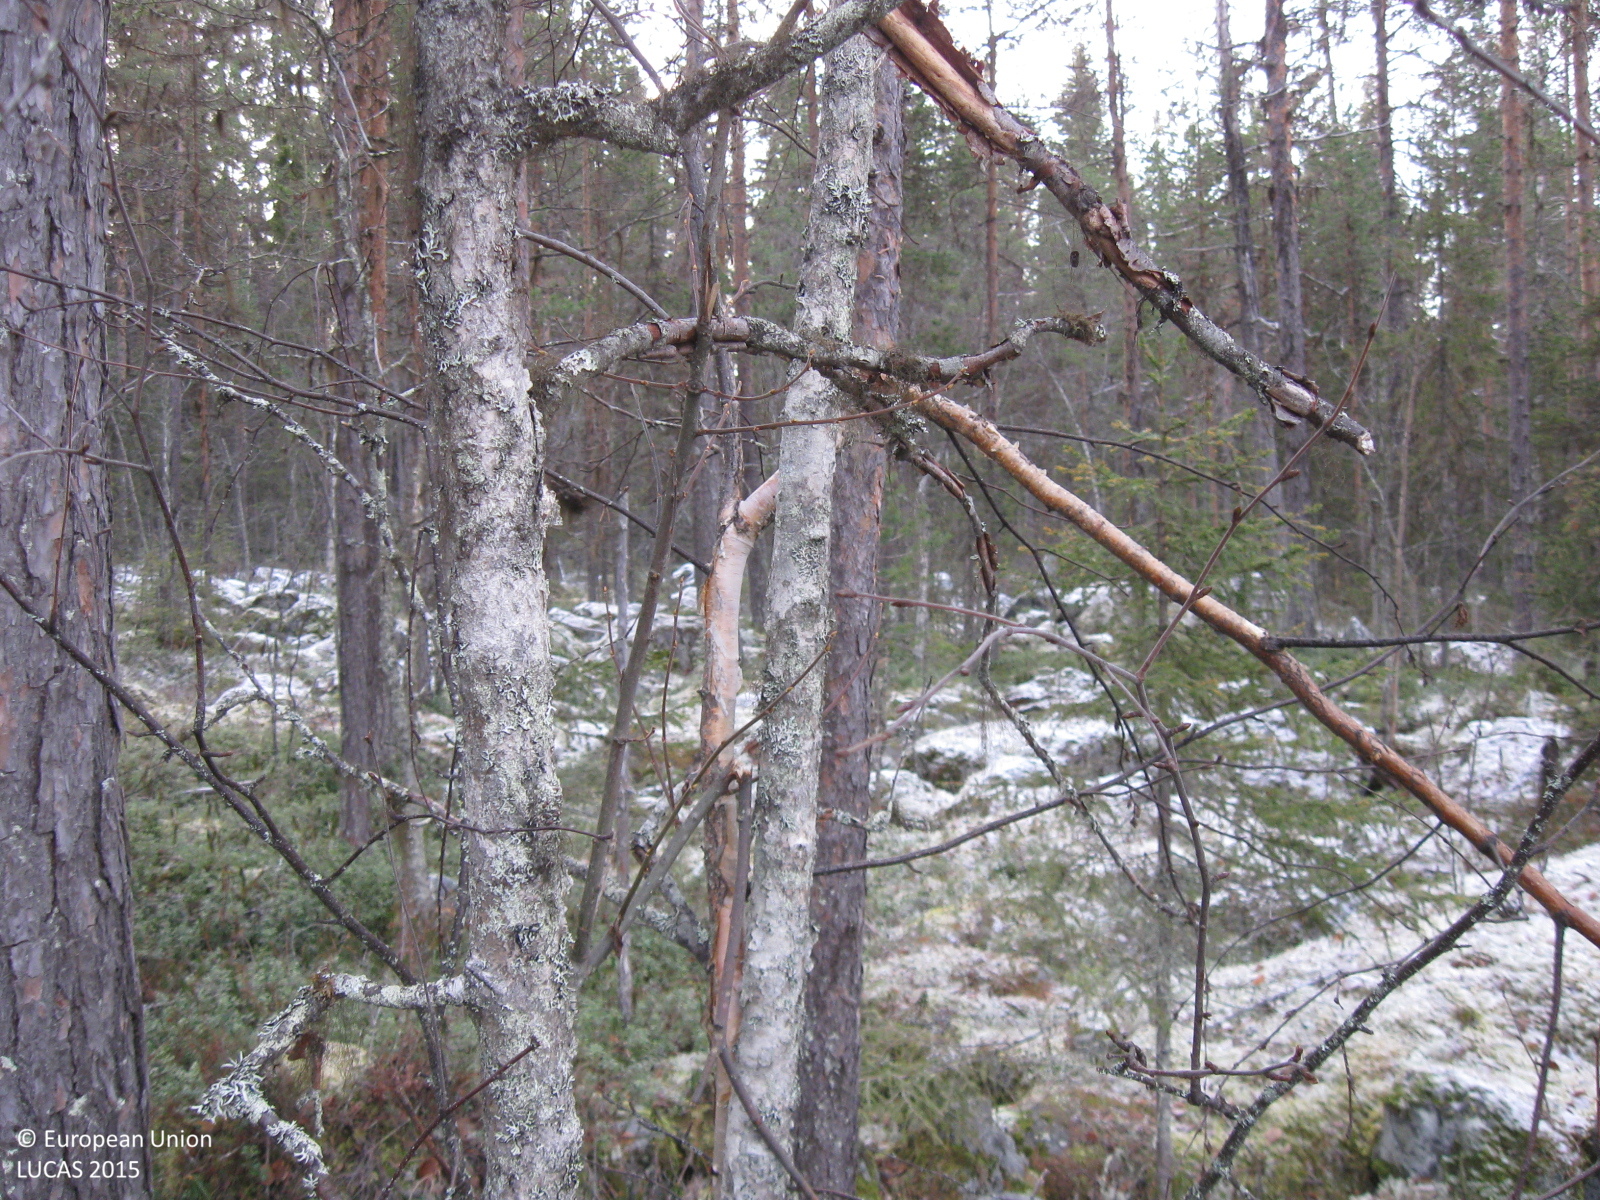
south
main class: Woodland
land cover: Pine dominated mixed woodland
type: boreal forest
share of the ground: 50 - 75 %
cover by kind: coniferous forest trees 45 %, broadleaved forest trees 25 %, unconsolidated bare surface 15 %, shrubs 5 %, herbaceous plants 5 %, lichens and mosses 5 %
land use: Forestry
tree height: > 5 m
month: October
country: SE
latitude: 66.2213
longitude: 21.6357
